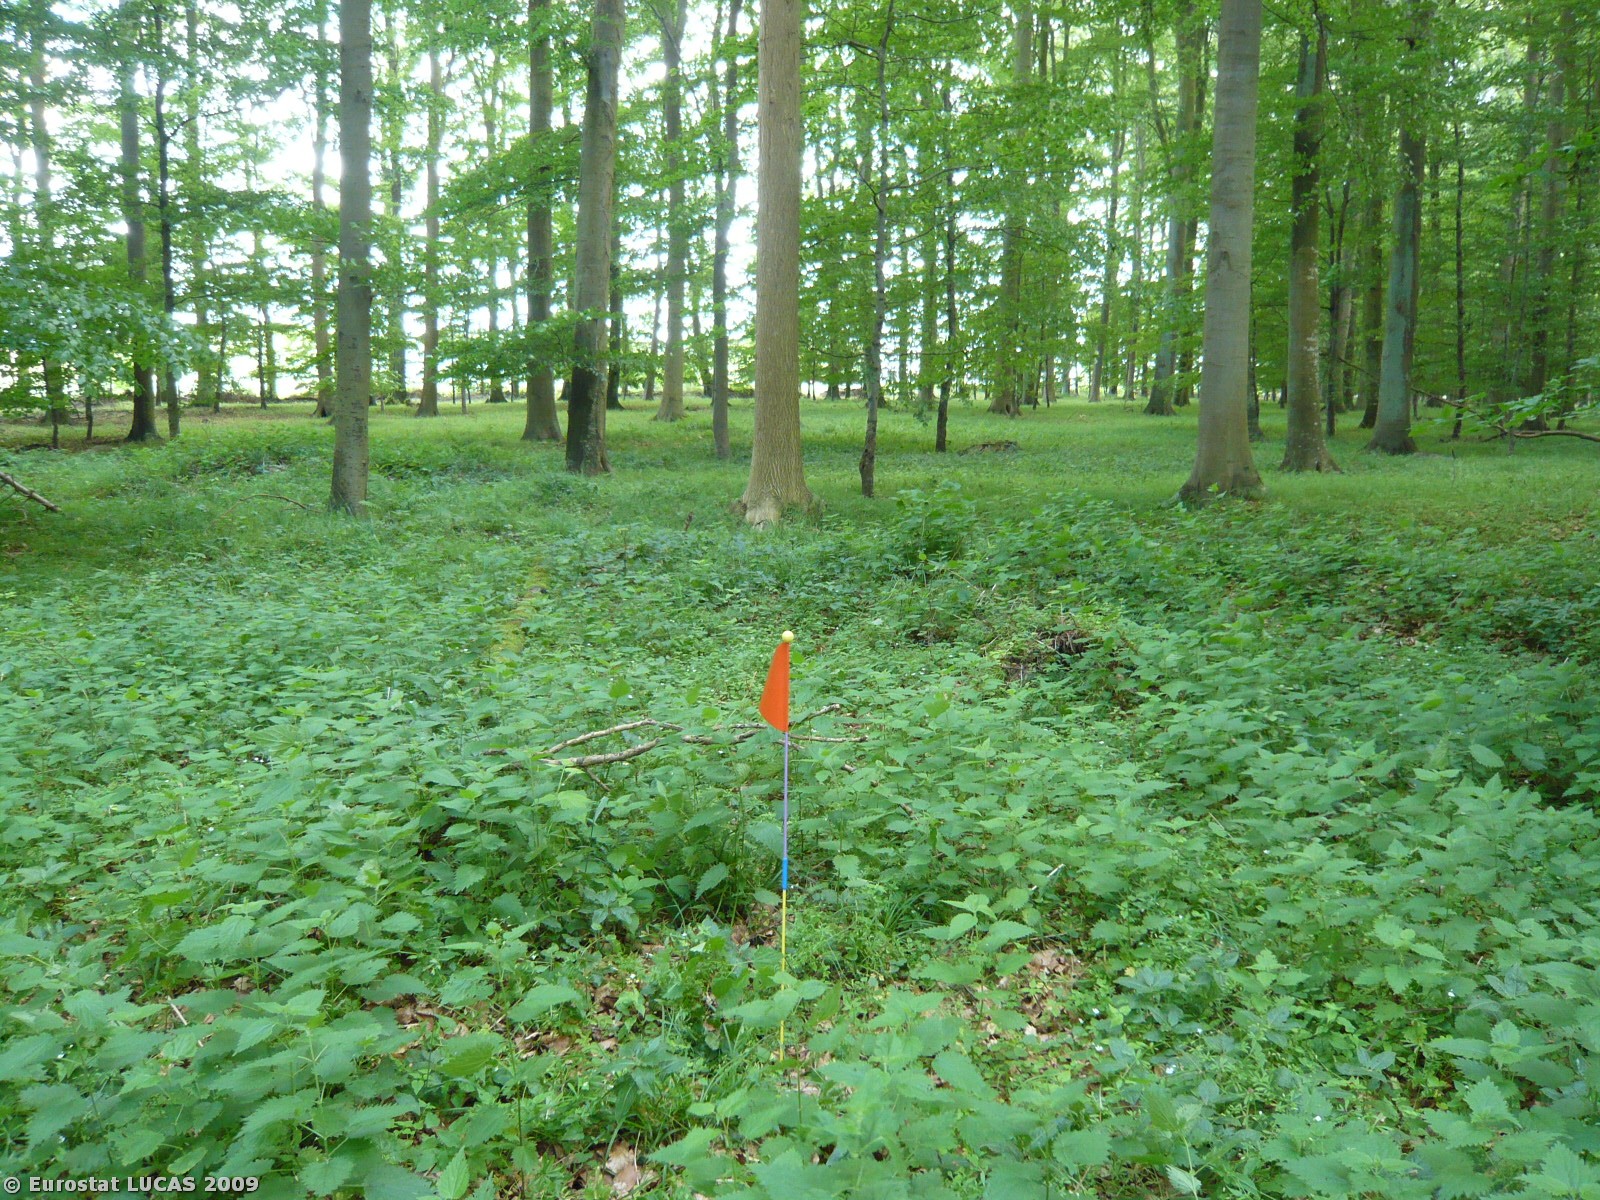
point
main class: Woodland
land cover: Broadleaved woodland
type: mesophytic deciduous forest
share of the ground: > 75 %
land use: Forestry
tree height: > 5 m
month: June
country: DK
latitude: 54.8686
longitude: 11.3235
